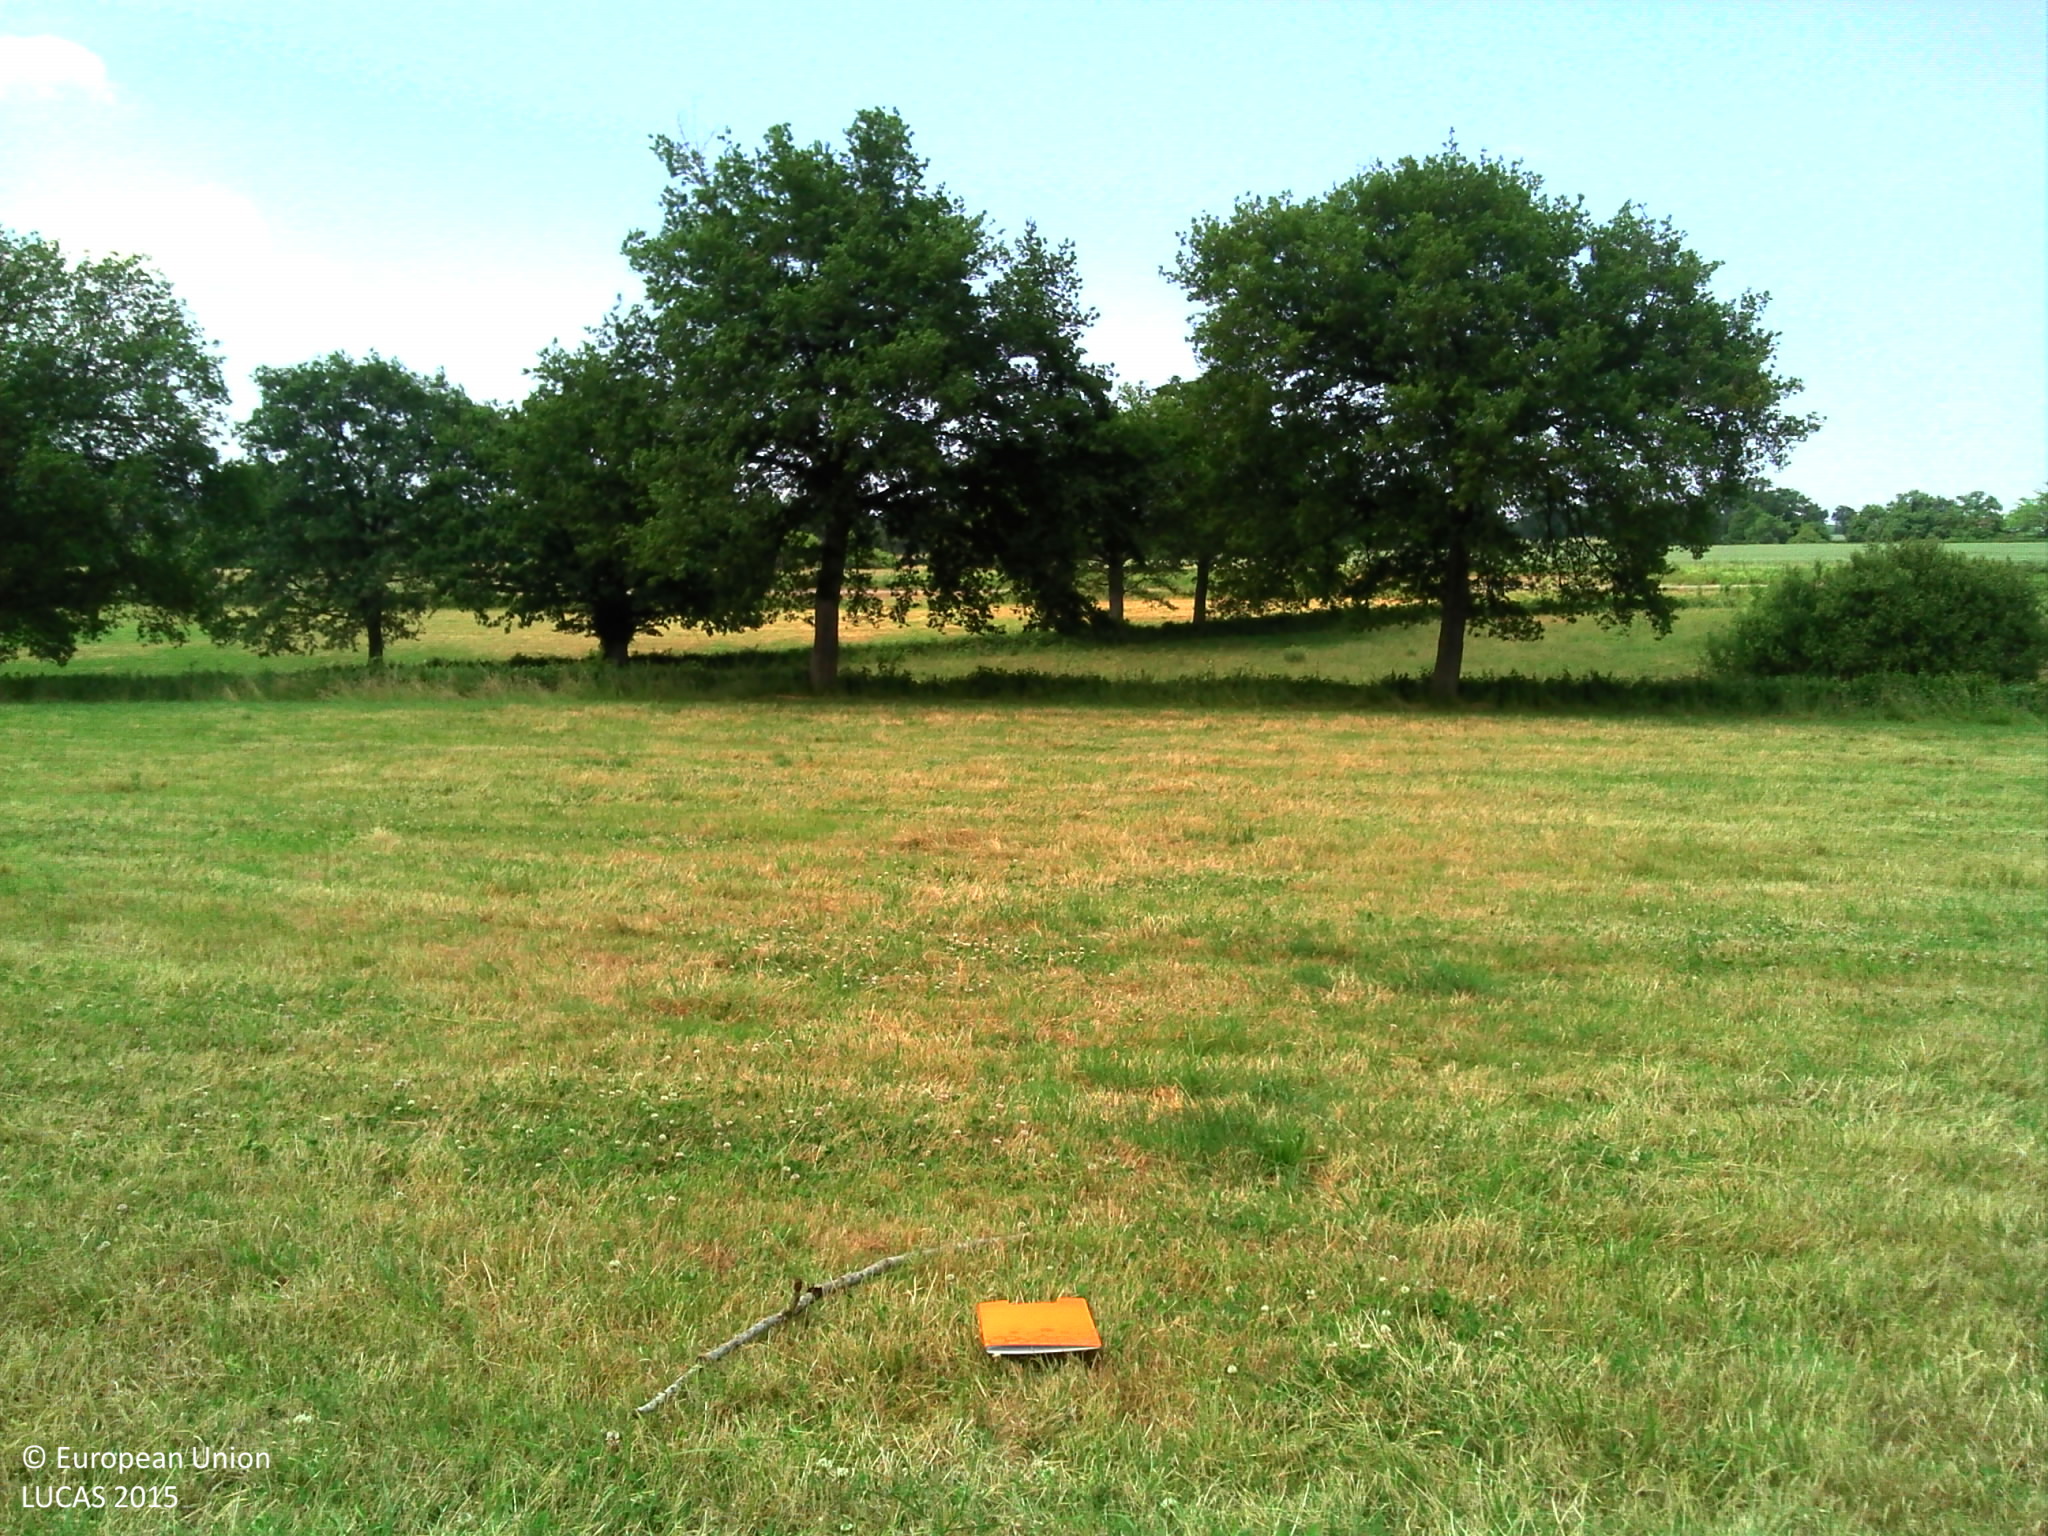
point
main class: Cropland
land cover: Temporary grasslands
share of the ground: > 75 %
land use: Agriculture (excluding fallow land and kitchen gardens)
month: June
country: FR
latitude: 46.3204
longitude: 2.9974
